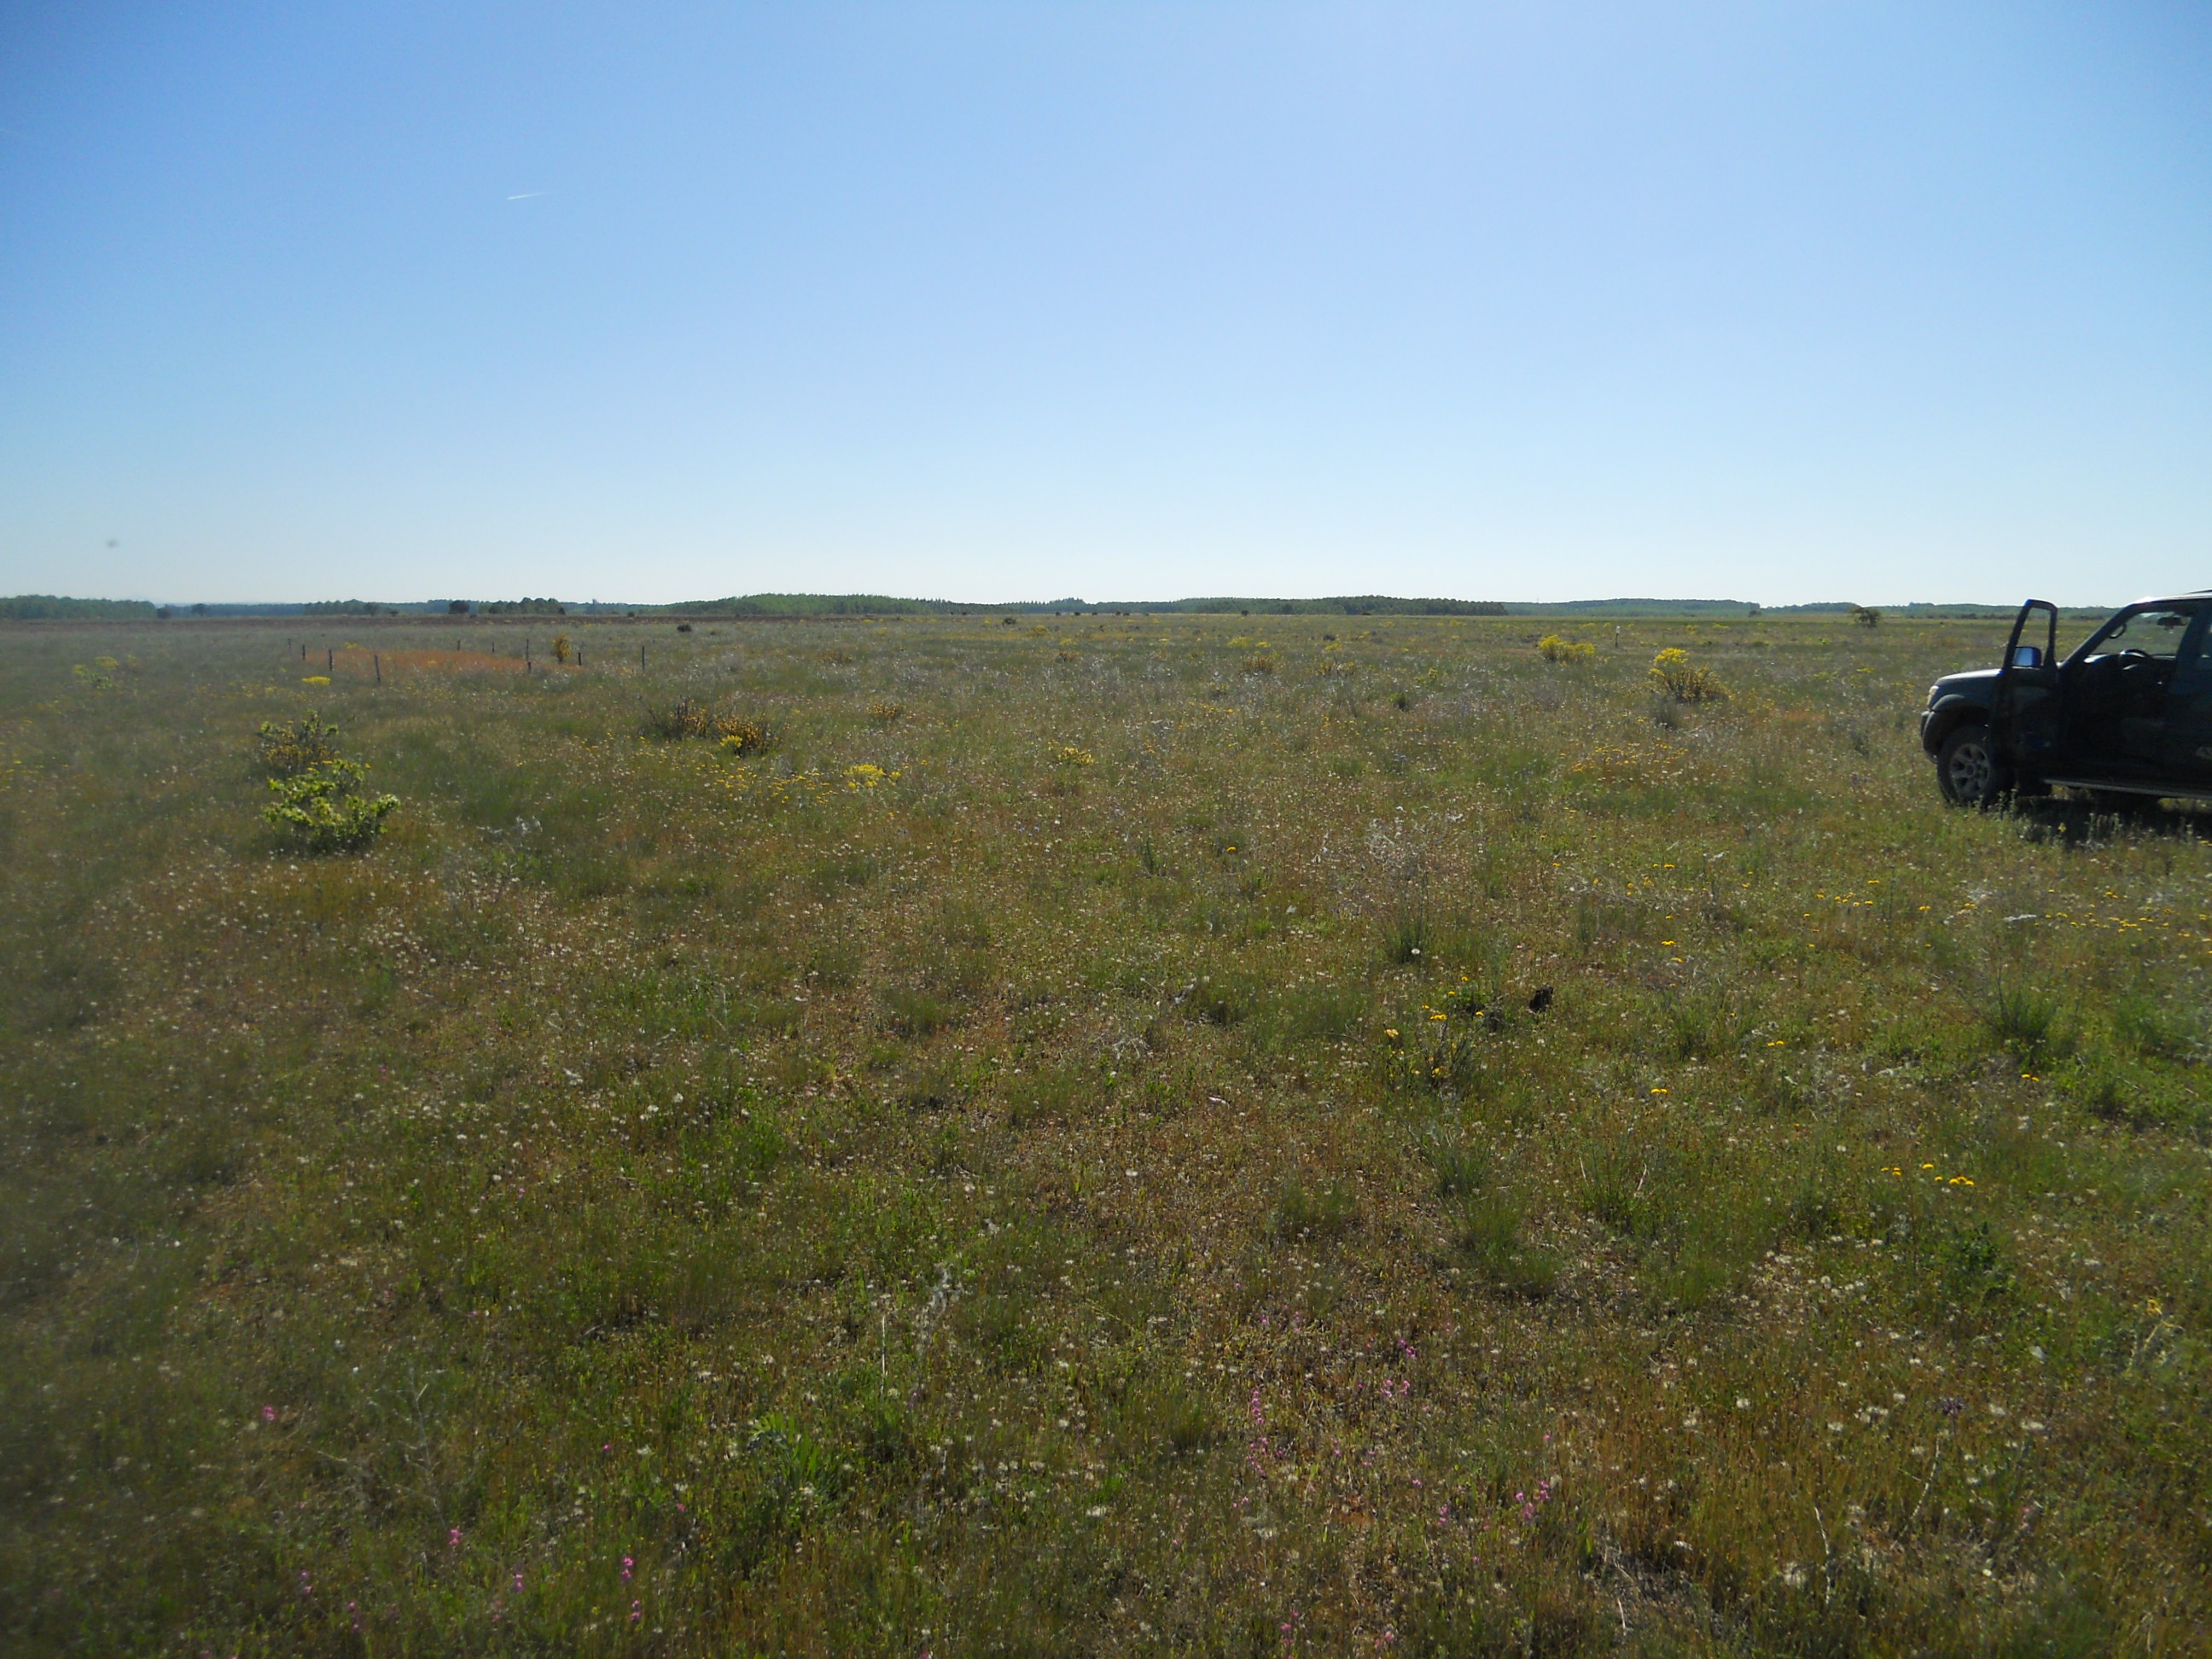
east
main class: Grassland
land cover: Spontaneously vegetated surfaces
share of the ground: > 75 %
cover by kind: herbaceous plants 100 %
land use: Fallow land
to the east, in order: Spontaneously vegetated surfaces
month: May
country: ES
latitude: 42.4718
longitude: -5.5545
